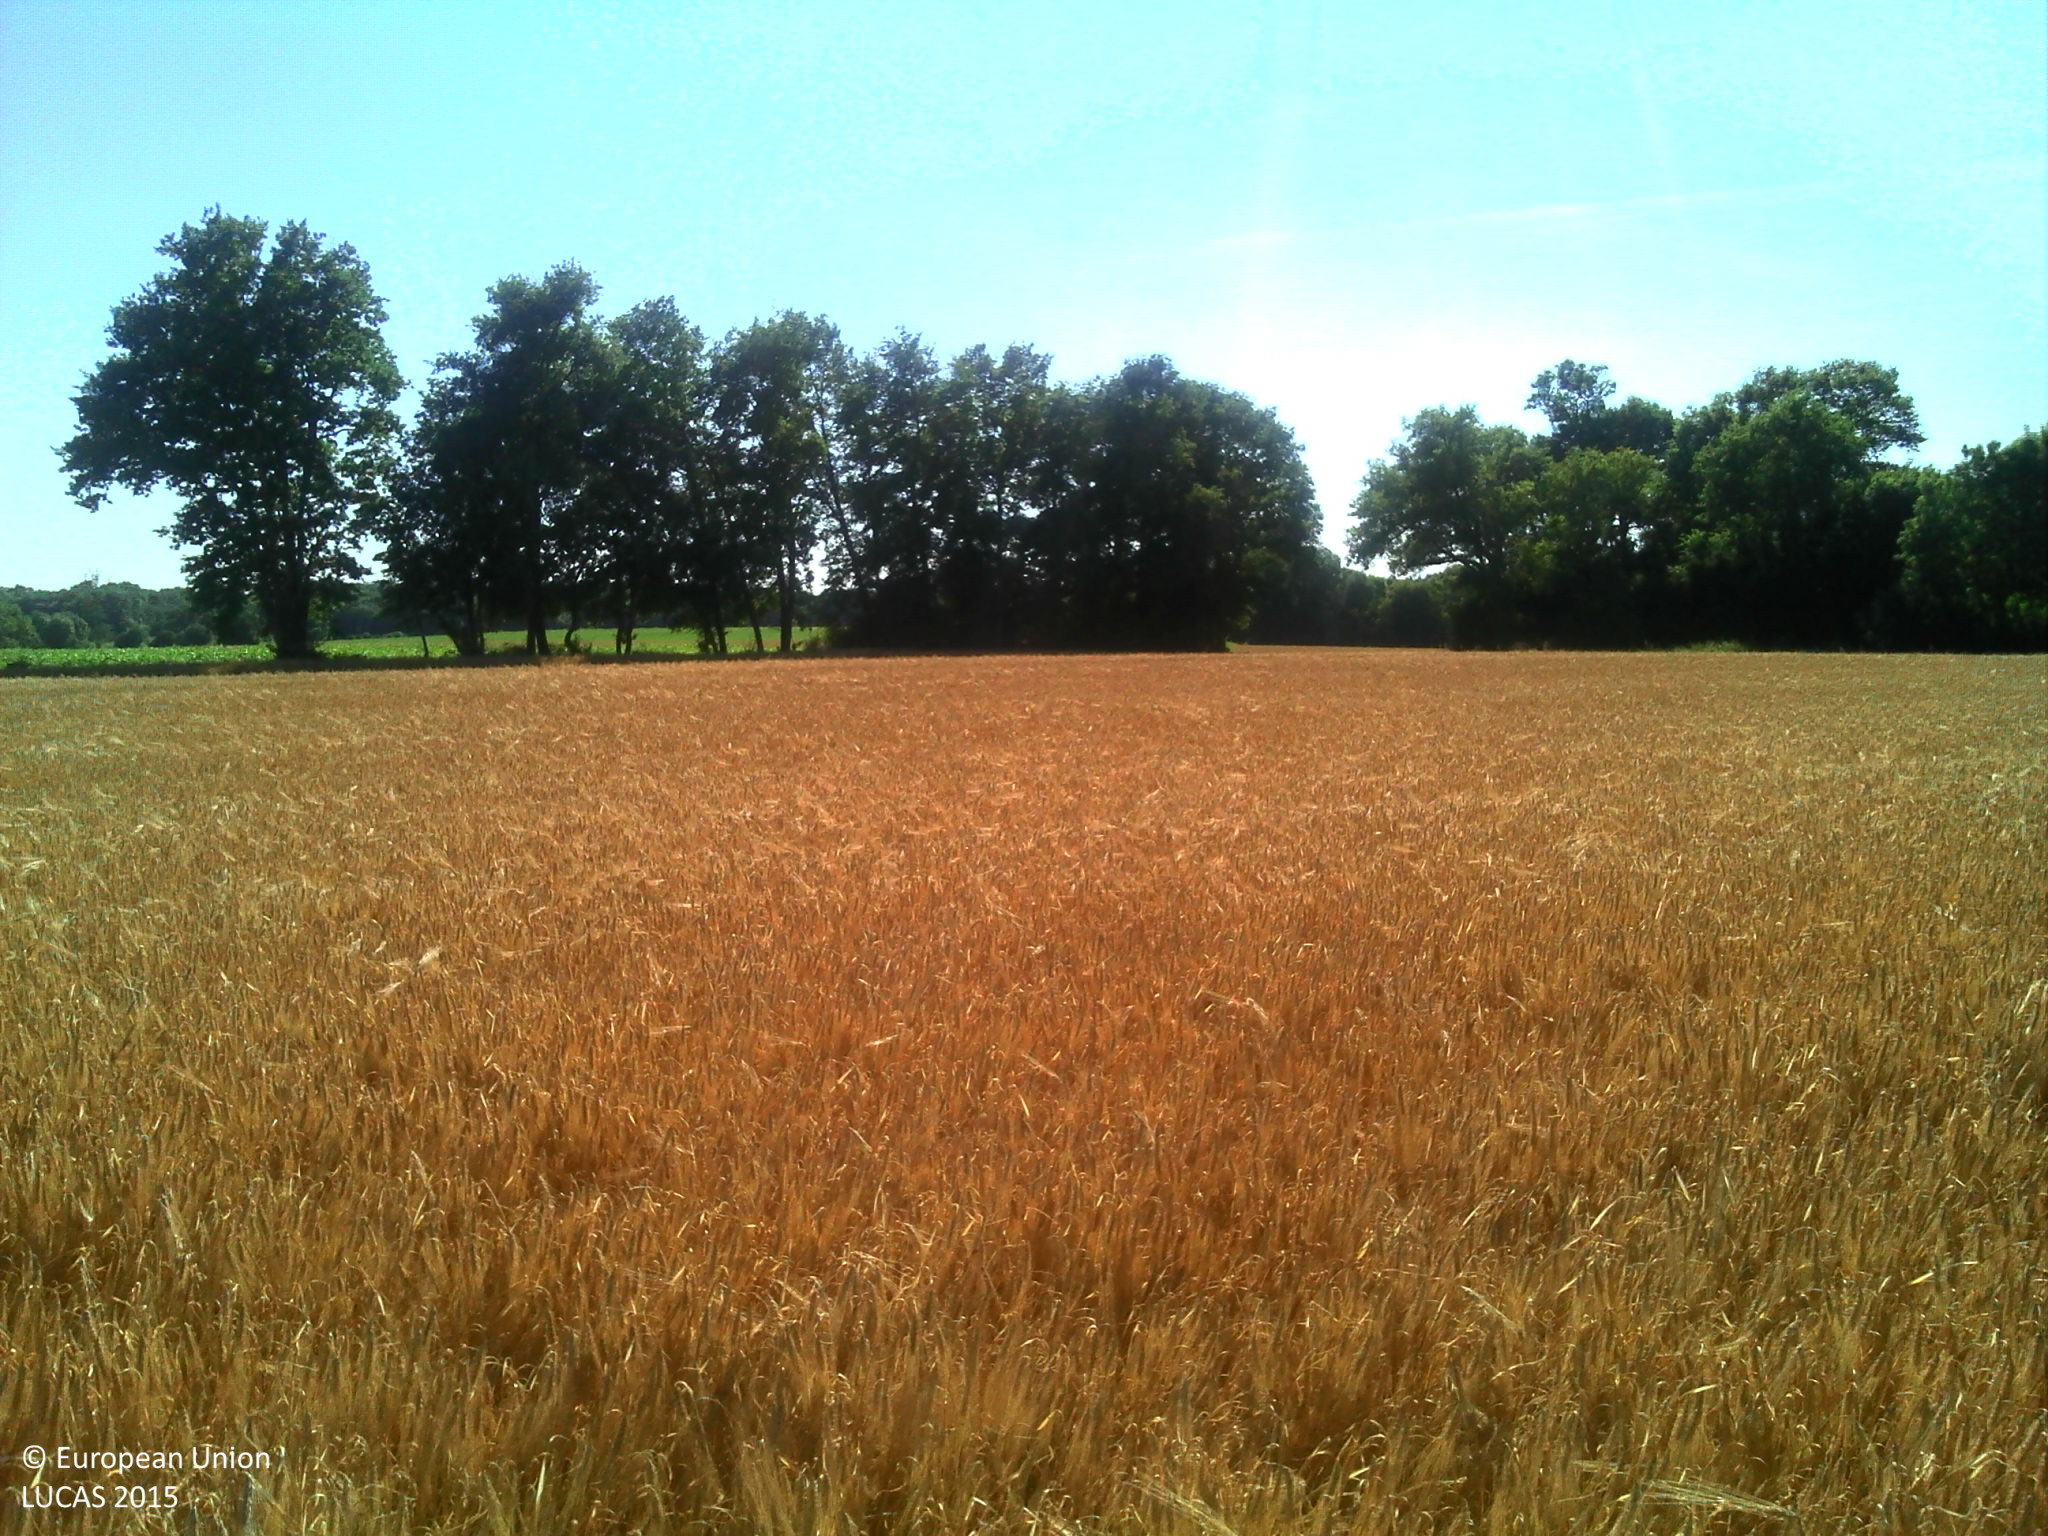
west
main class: Cropland
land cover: Barley
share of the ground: > 75 %
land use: Agriculture (excluding fallow land and kitchen gardens)
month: June
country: FR
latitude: 45.7193
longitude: -0.7270
